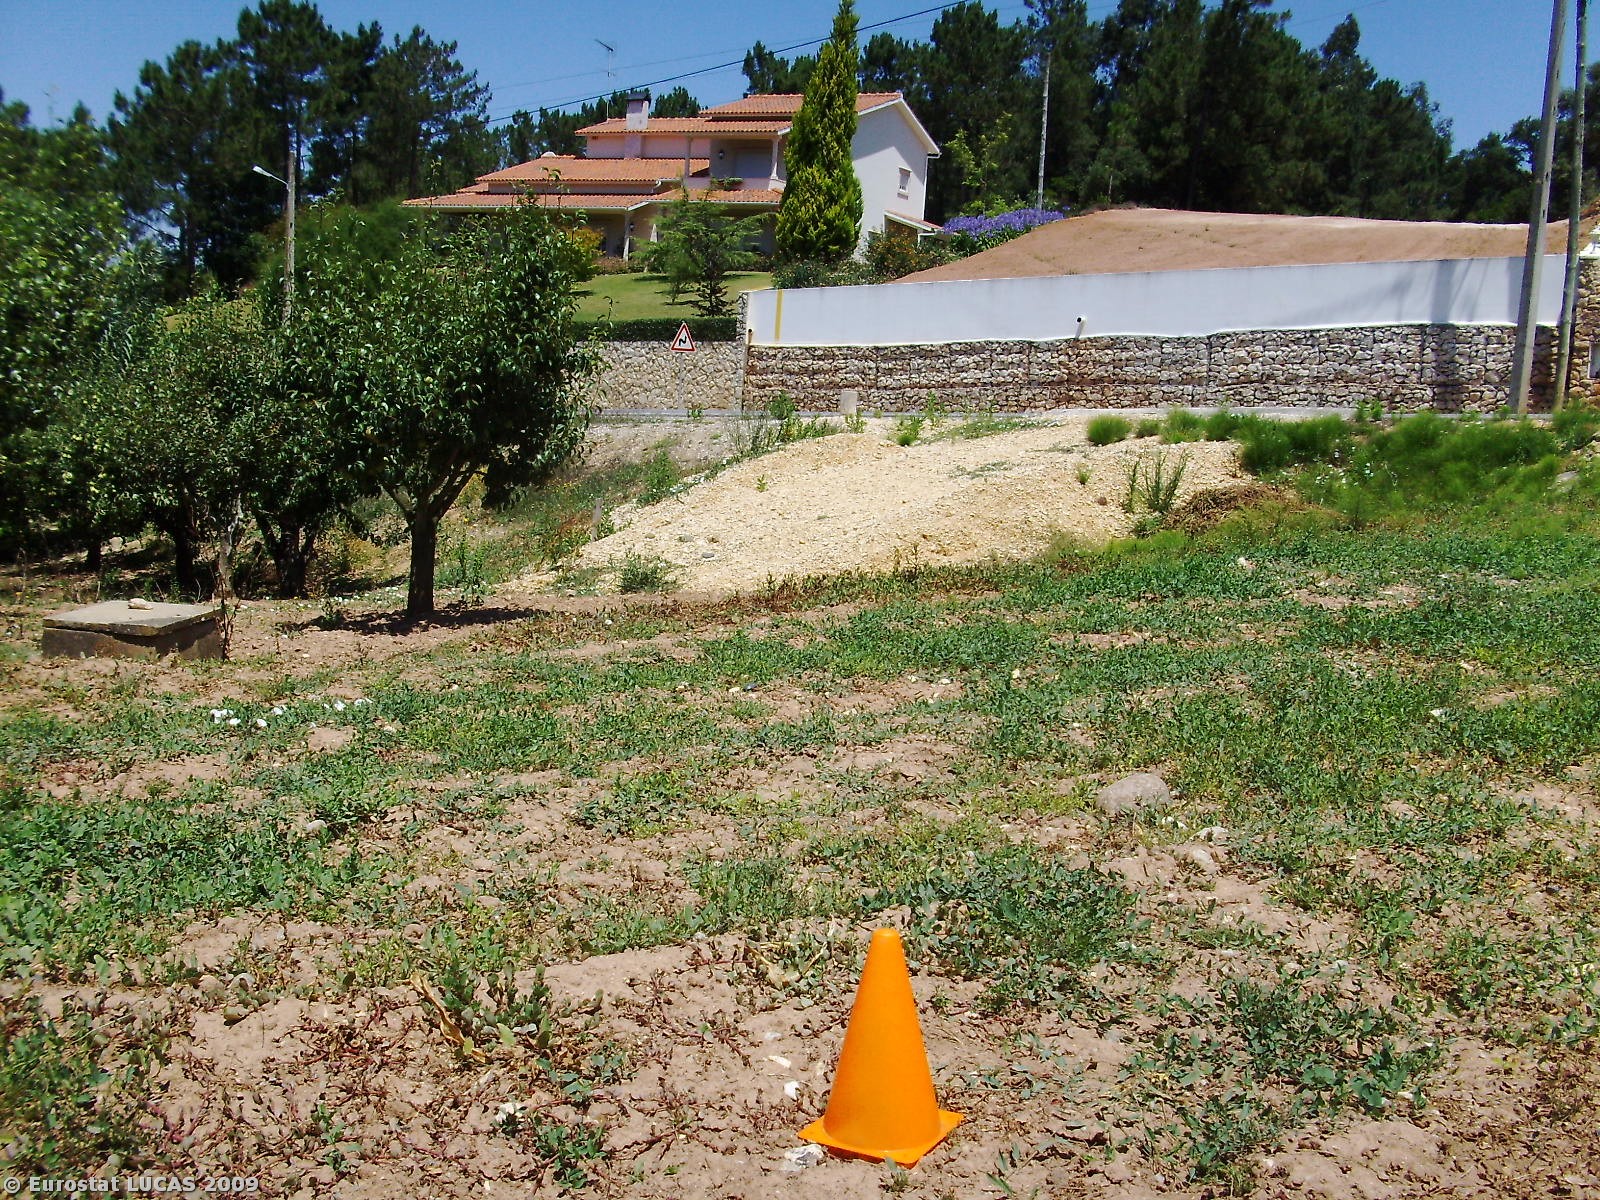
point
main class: Cropland
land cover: Pear fruit
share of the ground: 10 - 25 %
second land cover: Bare land
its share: 50 - 75 %
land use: Agriculture (excluding fallow land and kitchen gardens)
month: July
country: PT
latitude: 39.5671
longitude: -8.9554
